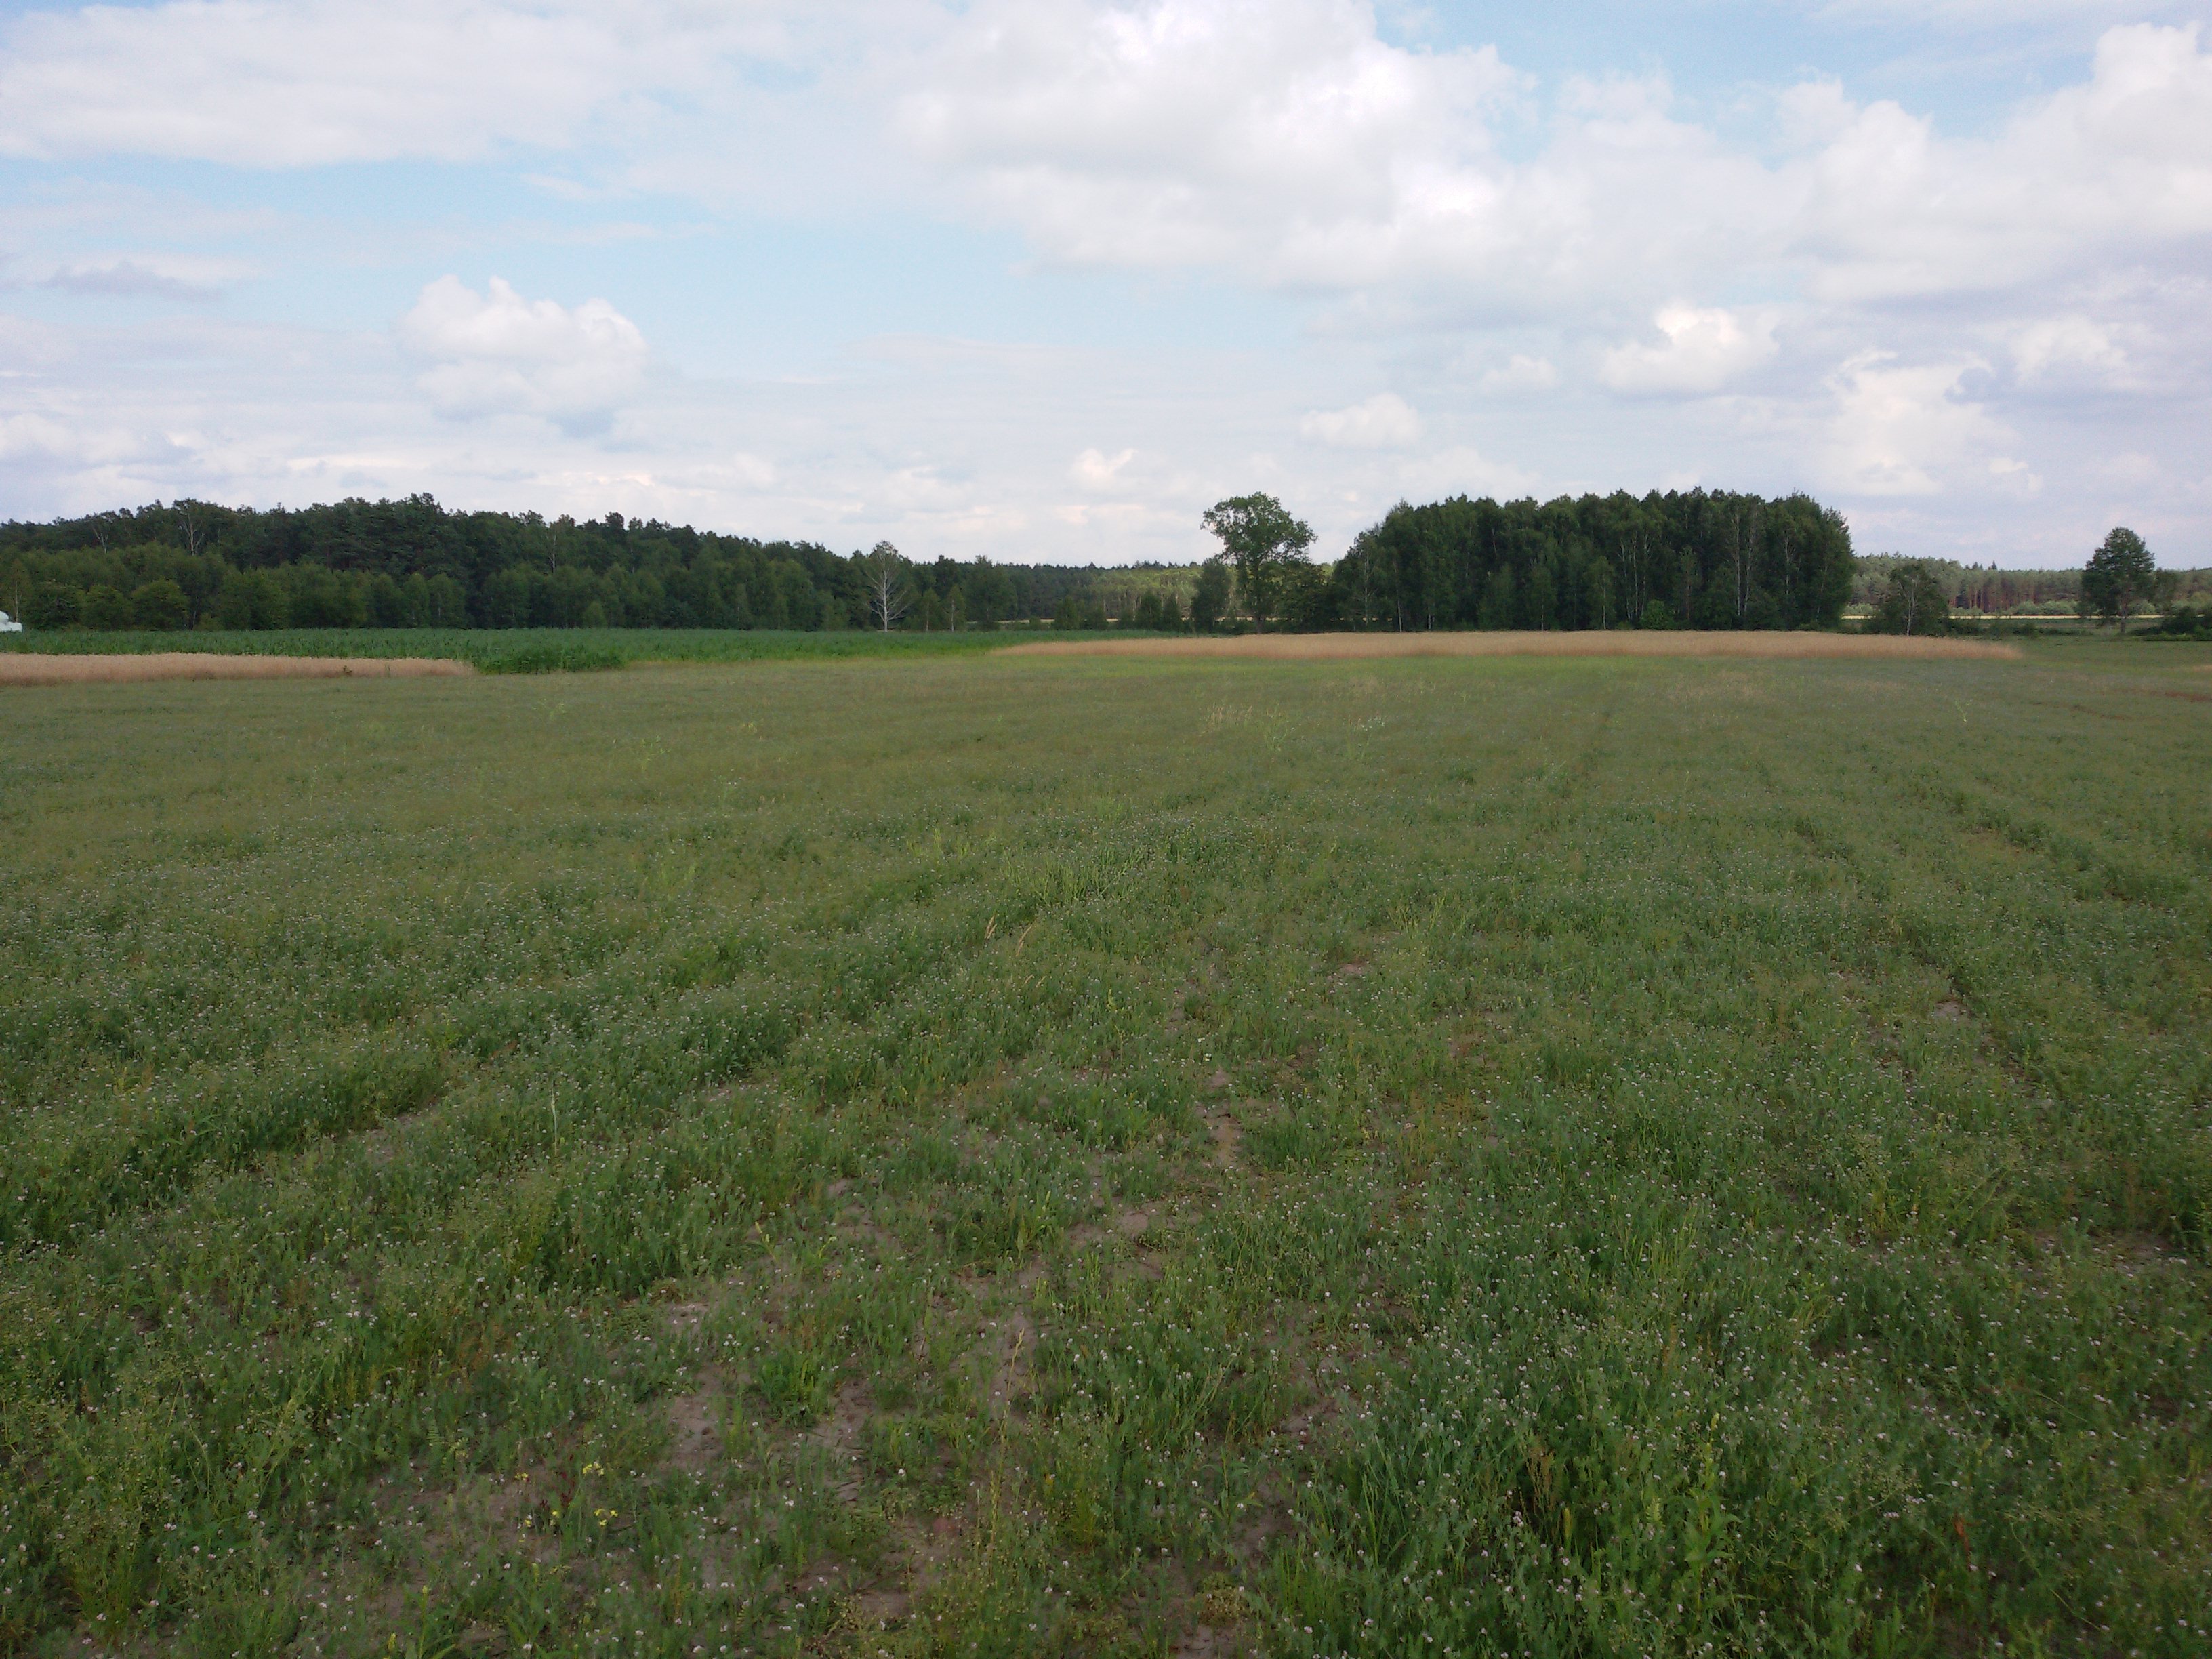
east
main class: Cropland
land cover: Dry pulses
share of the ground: > 75 %
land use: Agriculture (excluding fallow land and kitchen gardens)
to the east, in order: Dry pulses; Rye; Fences; Maize; Grassland without tree/shrub cover
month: July
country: PL
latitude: 51.9587
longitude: 22.9235
